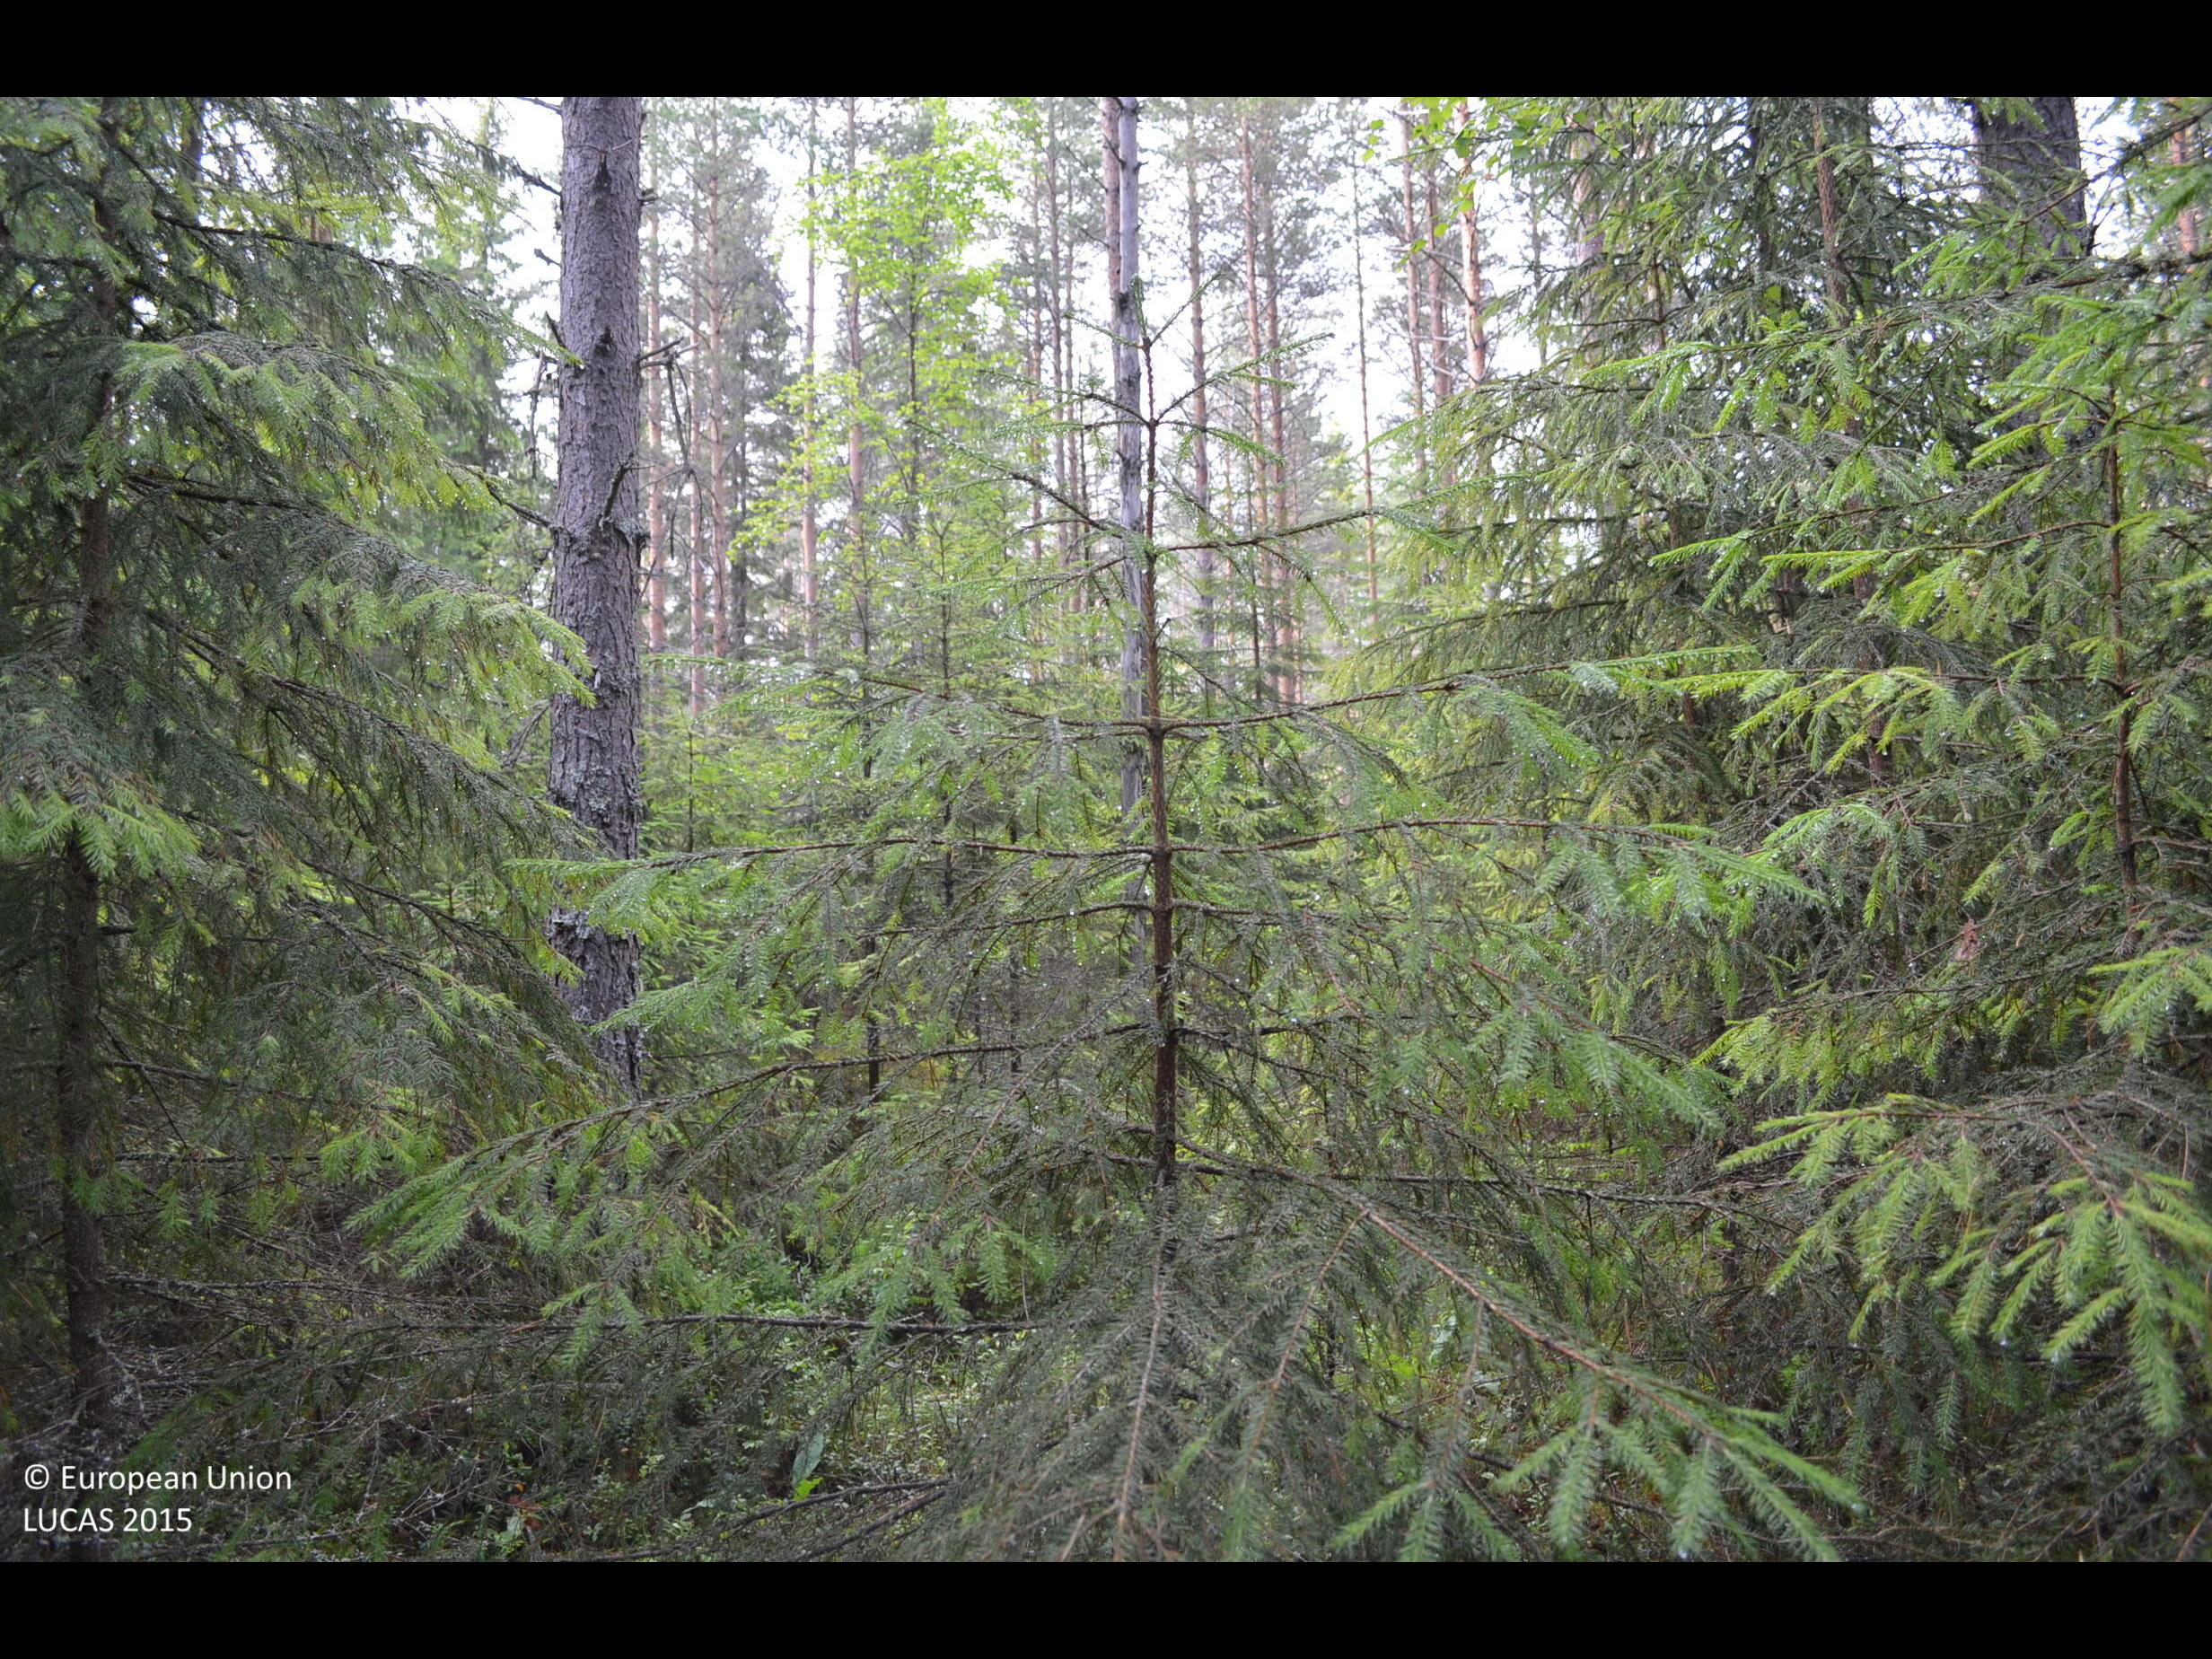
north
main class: Woodland
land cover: Other coniferous woodland
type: boreal forest
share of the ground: > 75 %
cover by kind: coniferous forest trees 85 %, shrubs 10 %, broadleaved forest trees 5 %
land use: Forestry
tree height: > 5 m
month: July
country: FI
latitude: 62.1732
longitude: 23.4185
